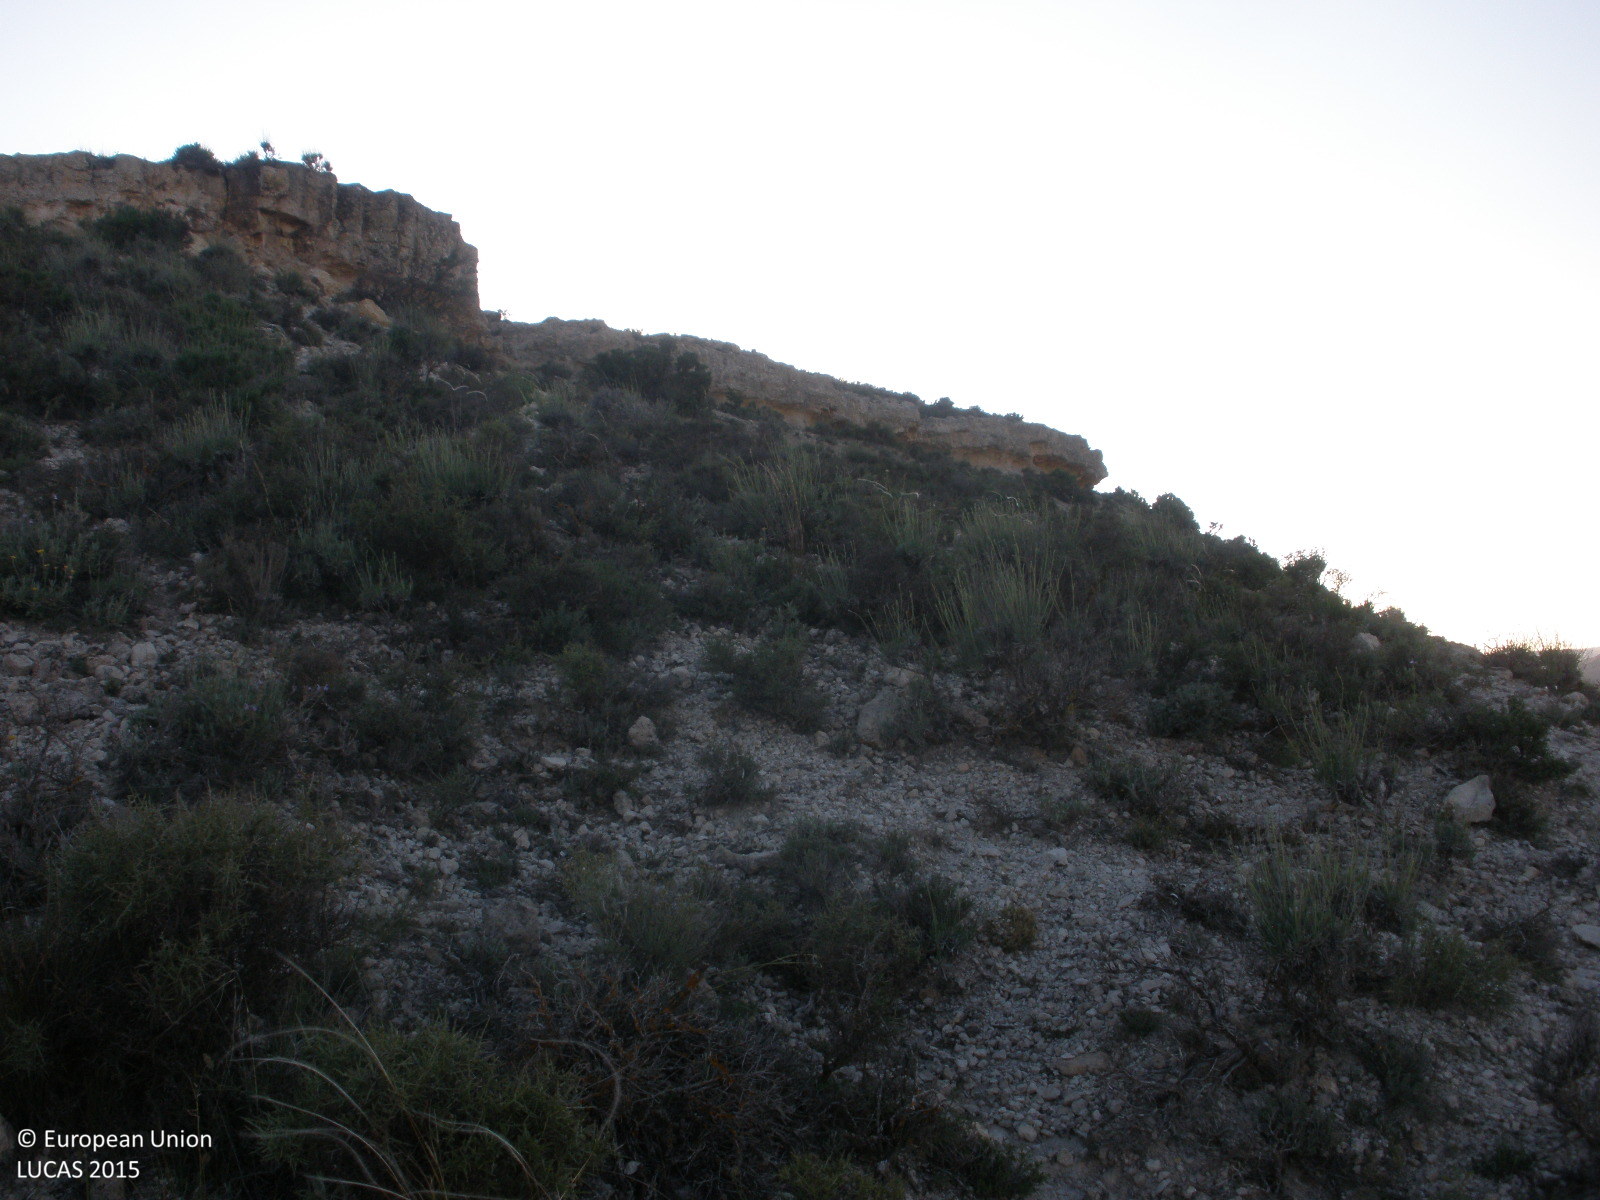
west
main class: Shrubland
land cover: Shrubland without tree cover
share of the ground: 25 - 50 %
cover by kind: shrubs 40 %, herbaceous plants 30 %, consolidated bare surface 30 %
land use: Agriculture (excluding fallow land and kitchen gardens)
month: June
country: ES
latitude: 40.4991
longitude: -1.0444
